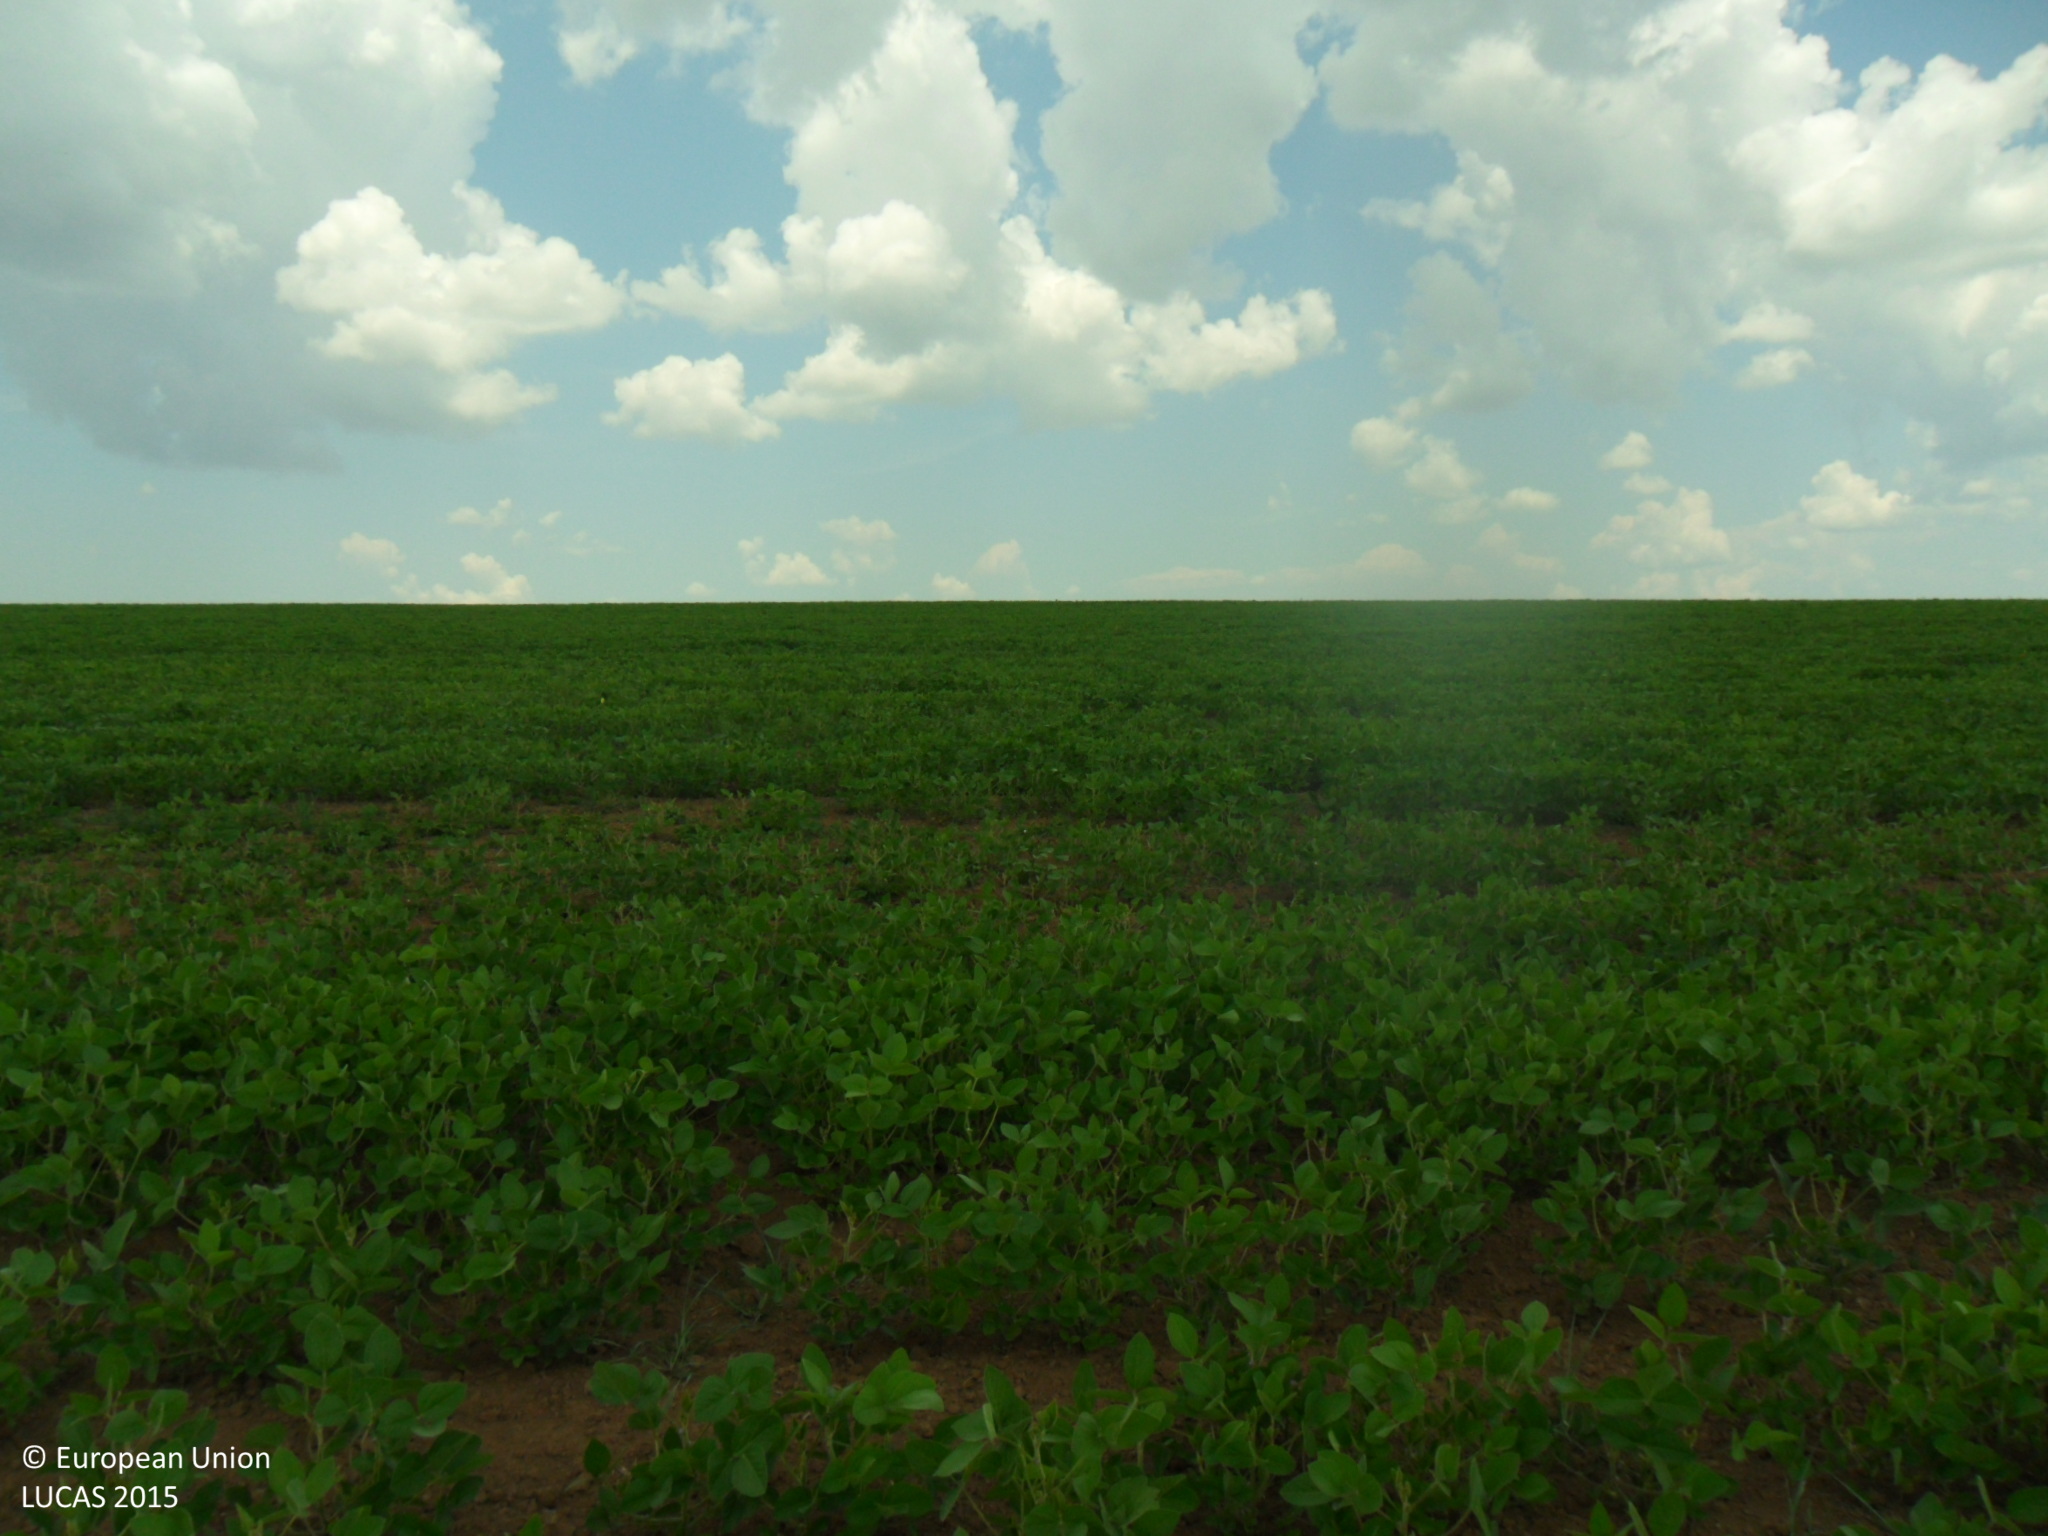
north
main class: Cropland
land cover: Soya
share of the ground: 50 - 75 %
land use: Agriculture (excluding fallow land and kitchen gardens)
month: July
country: BG
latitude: 43.6351
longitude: 26.8867
